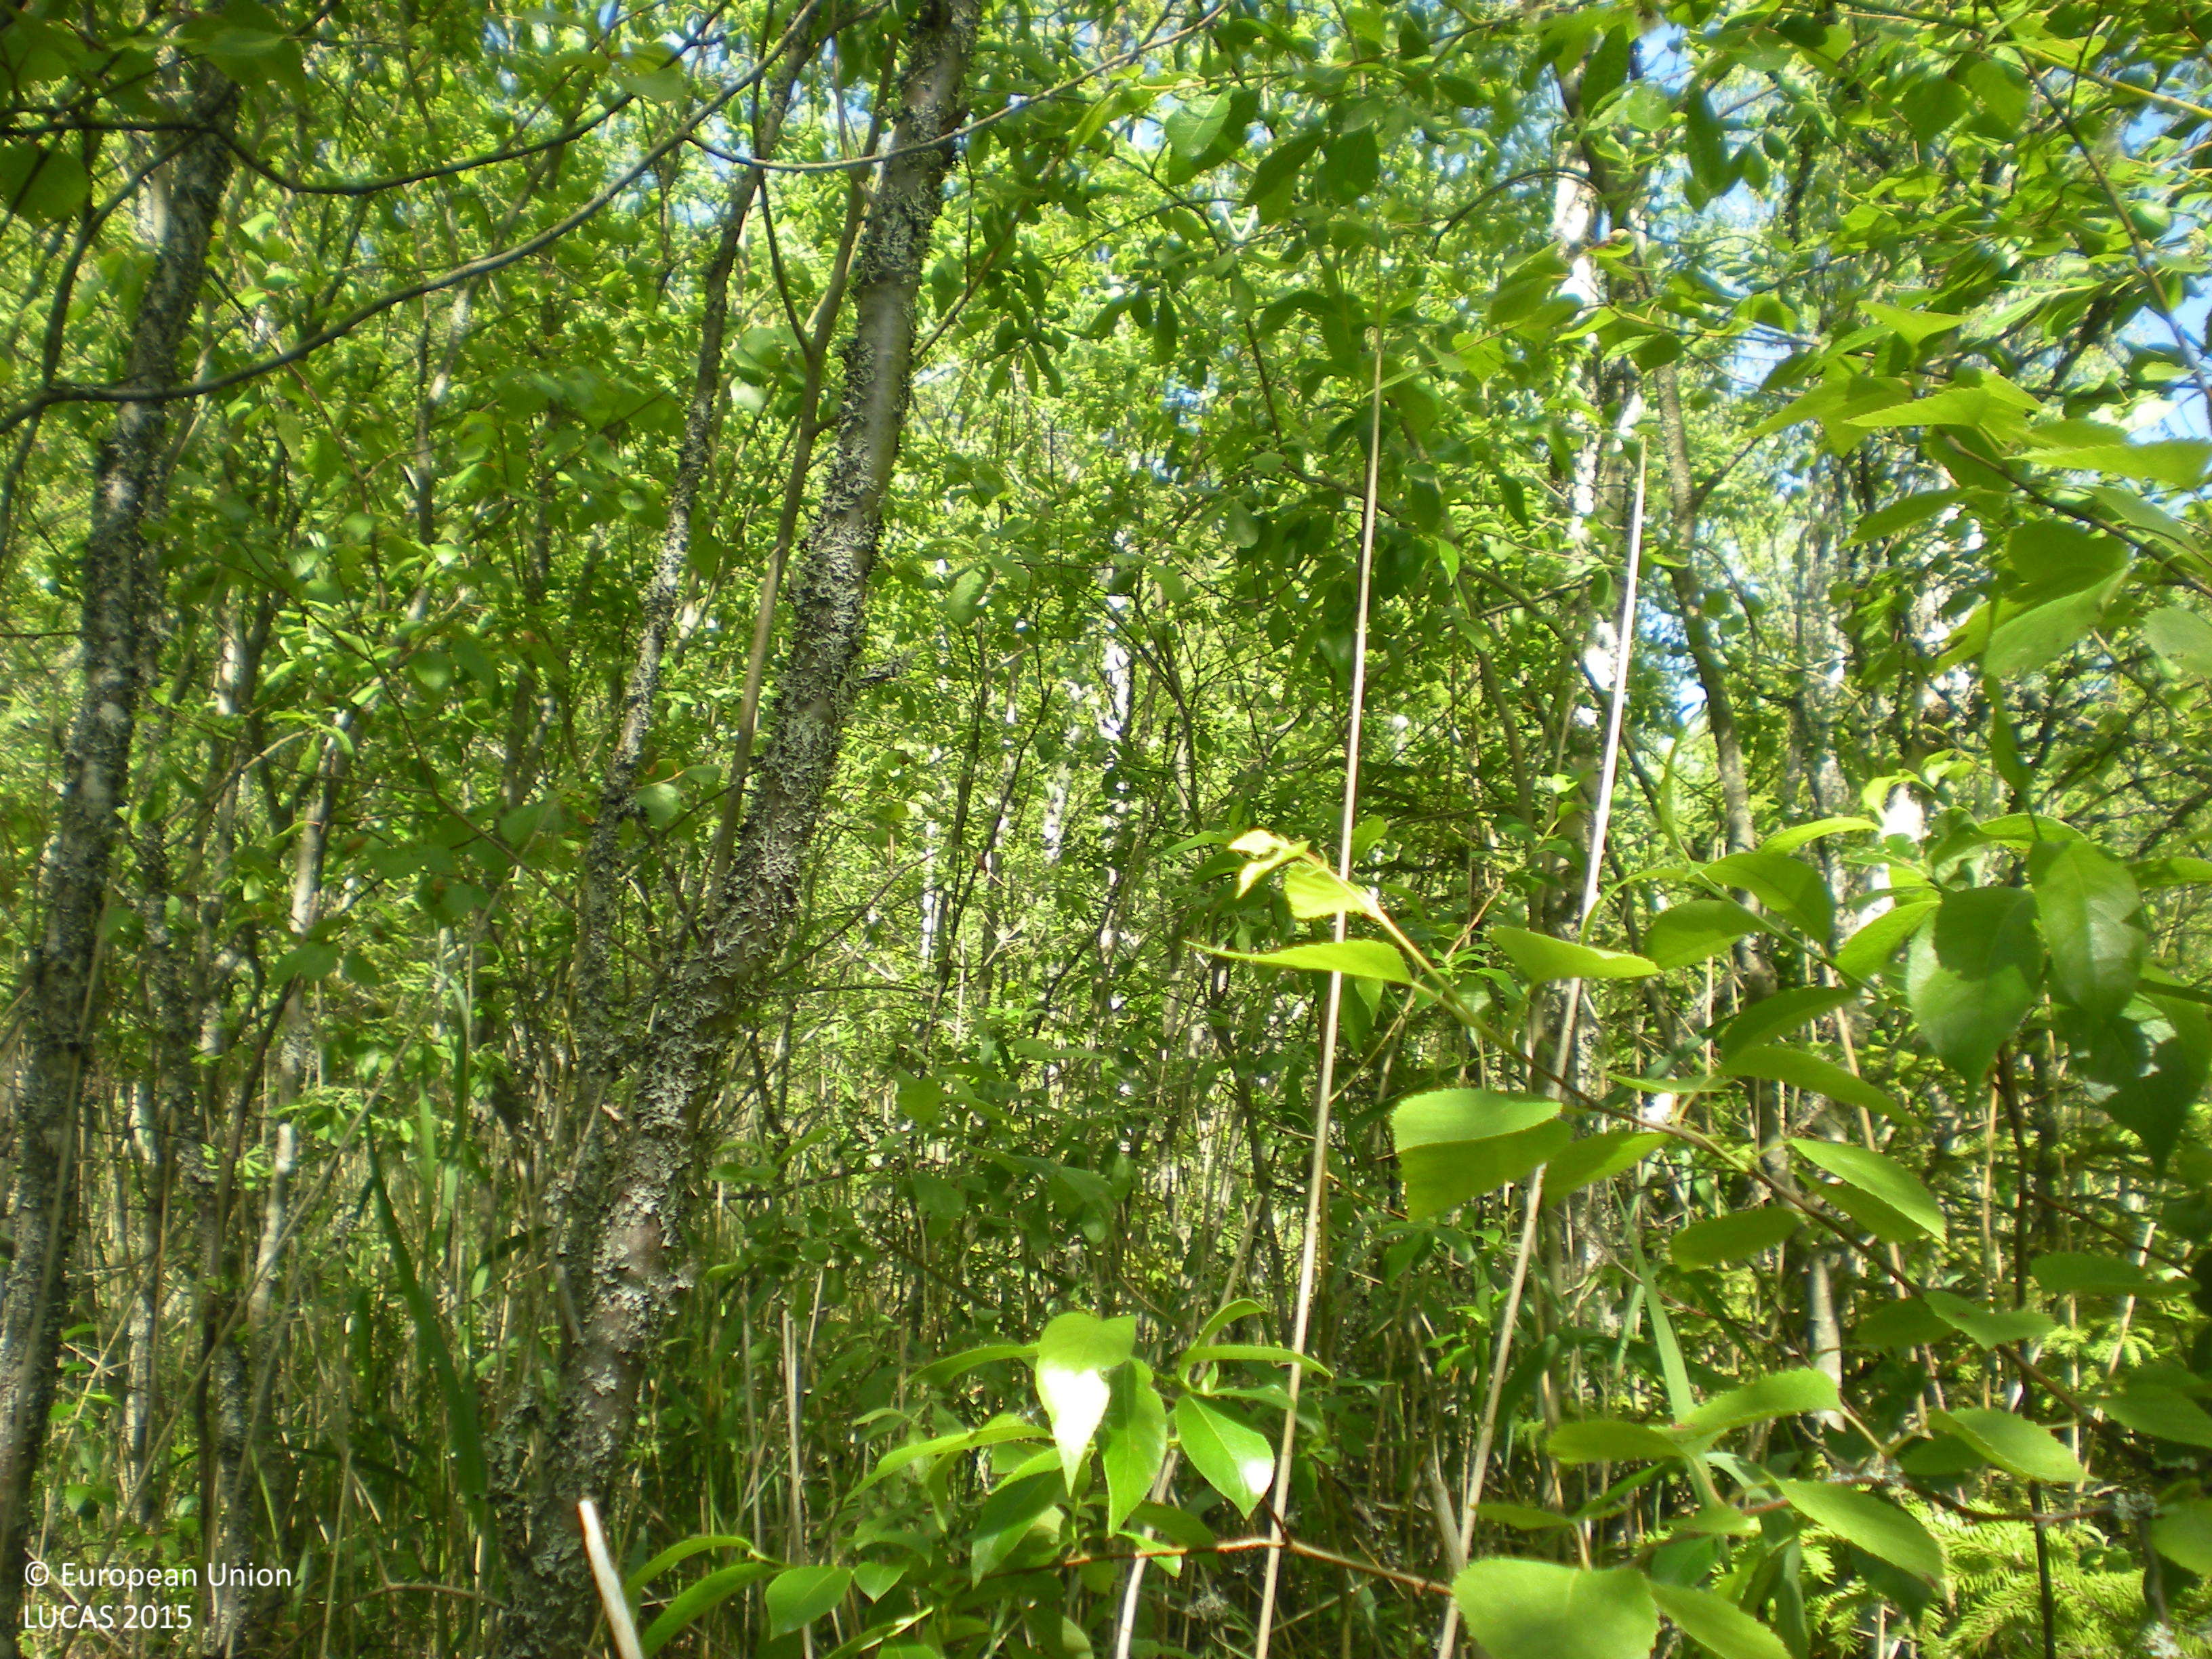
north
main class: Woodland
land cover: Broadleaved woodland
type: mire and swamp forests
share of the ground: > 75 %
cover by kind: broadleaved forest trees 80 %, herbaceous plants 10 %, coniferous forest trees 5 %, shrubs 5 %
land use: Semi-natural and natural areas not in use
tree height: < 5 m
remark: Temporary flooded
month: June
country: SE
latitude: 60.4776
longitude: 18.0160
